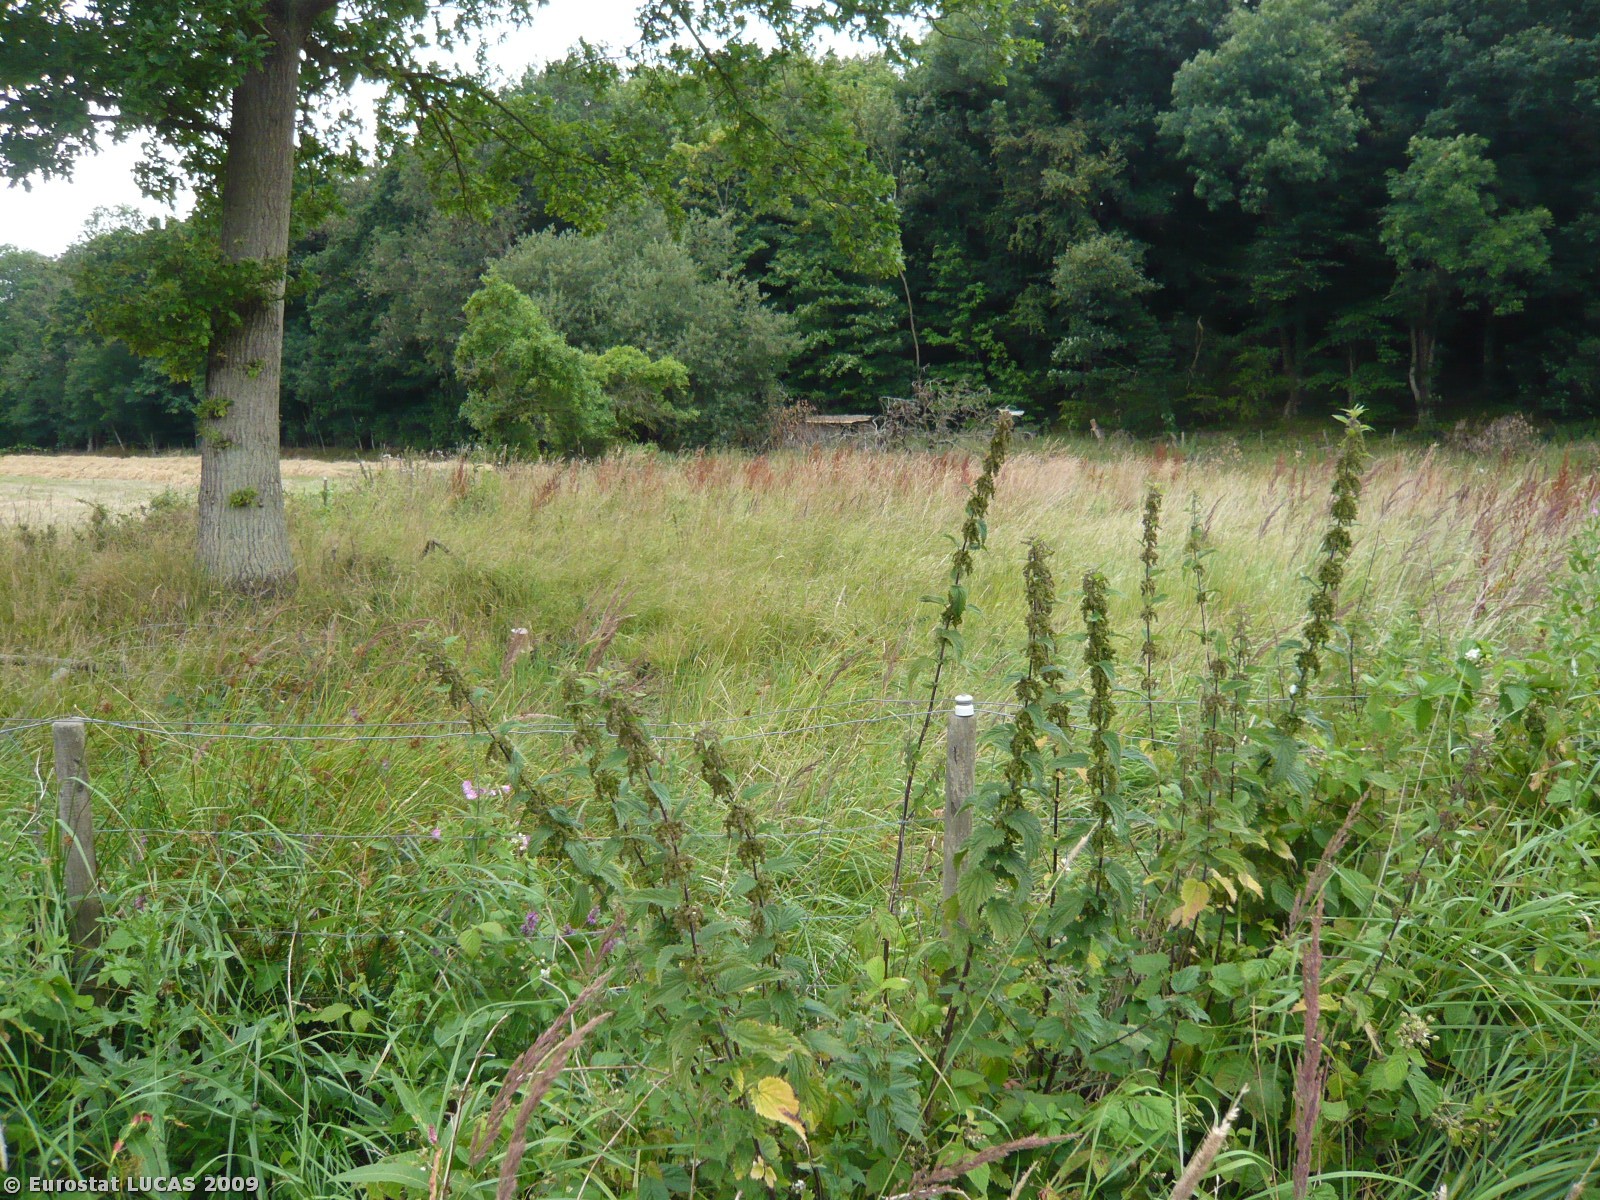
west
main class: Woodland
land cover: Broadleaved woodland
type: mesophytic deciduous forest
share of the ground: > 75 %
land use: Amenities, museums, leisure
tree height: > 5 m
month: August
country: DK
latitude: 55.9574
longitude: 11.9362
